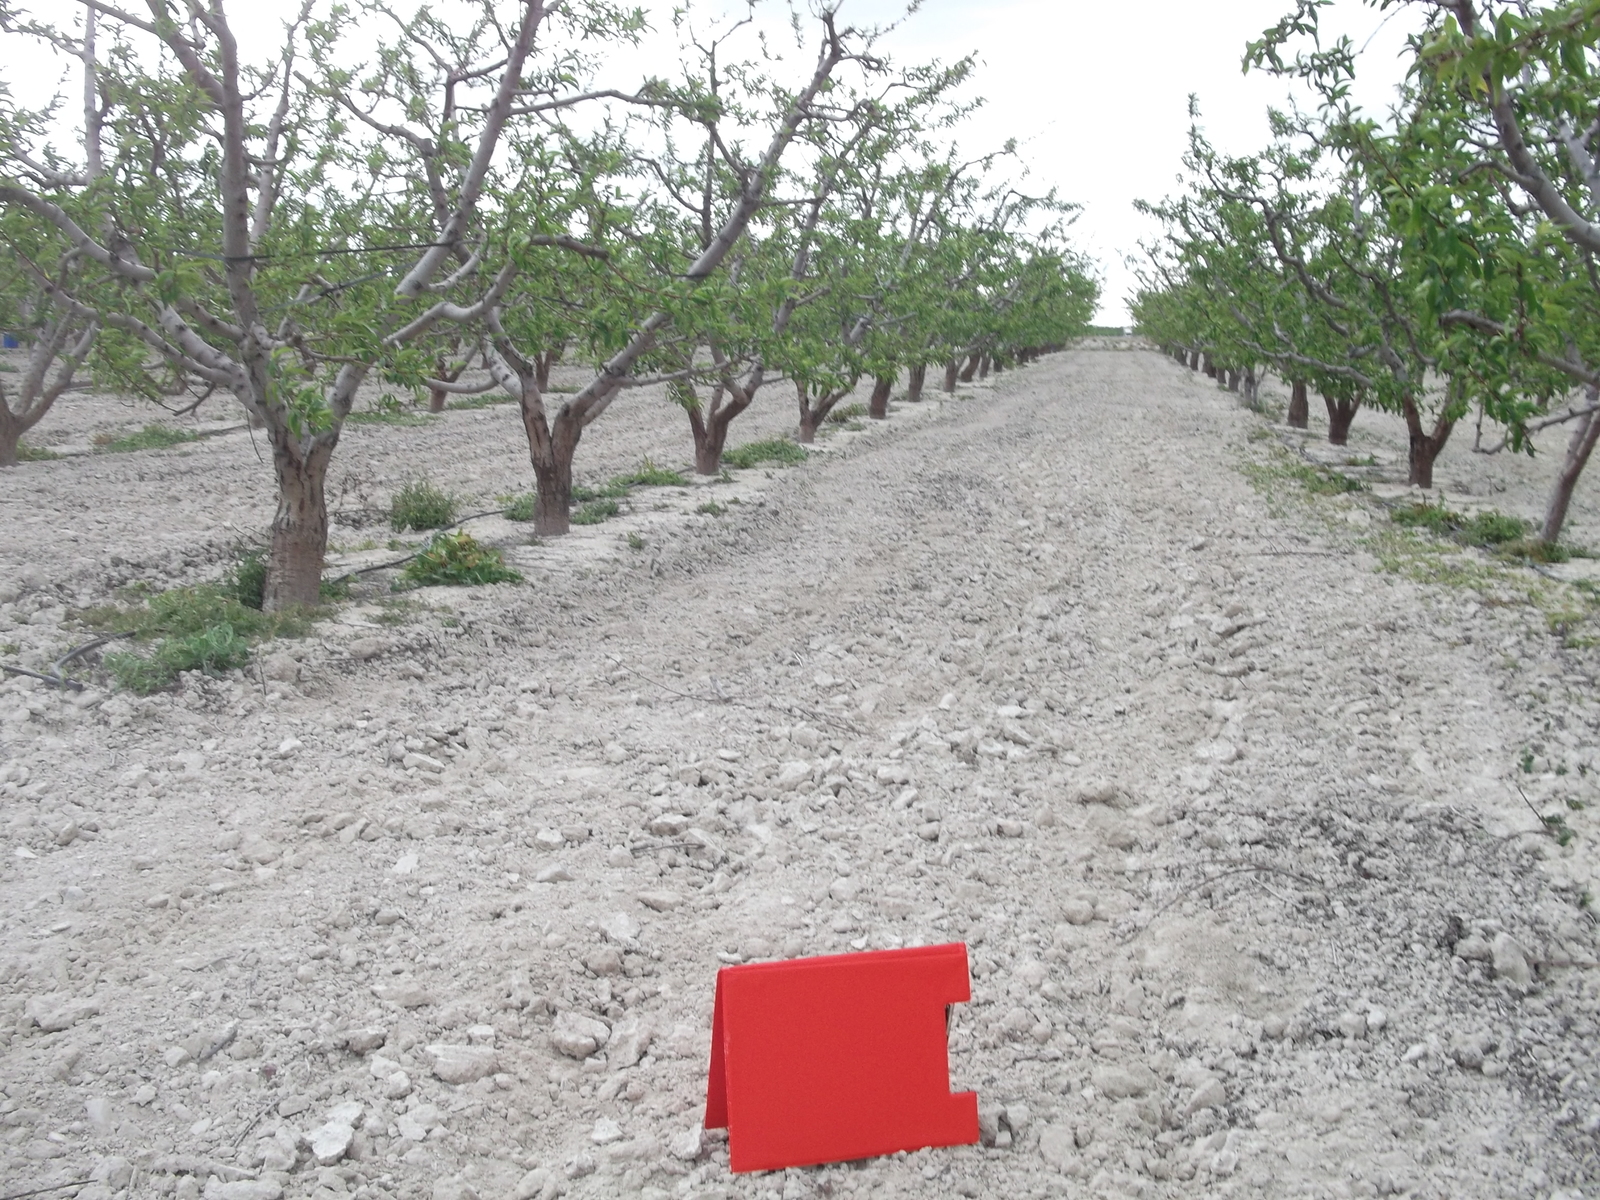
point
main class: Cropland
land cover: Nuts trees
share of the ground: 10 - 25 %
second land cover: Other bare soil
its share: > 75 %
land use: Agriculture (excluding fallow land and kitchen gardens)
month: April
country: ES
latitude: 38.0511
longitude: -1.3703
